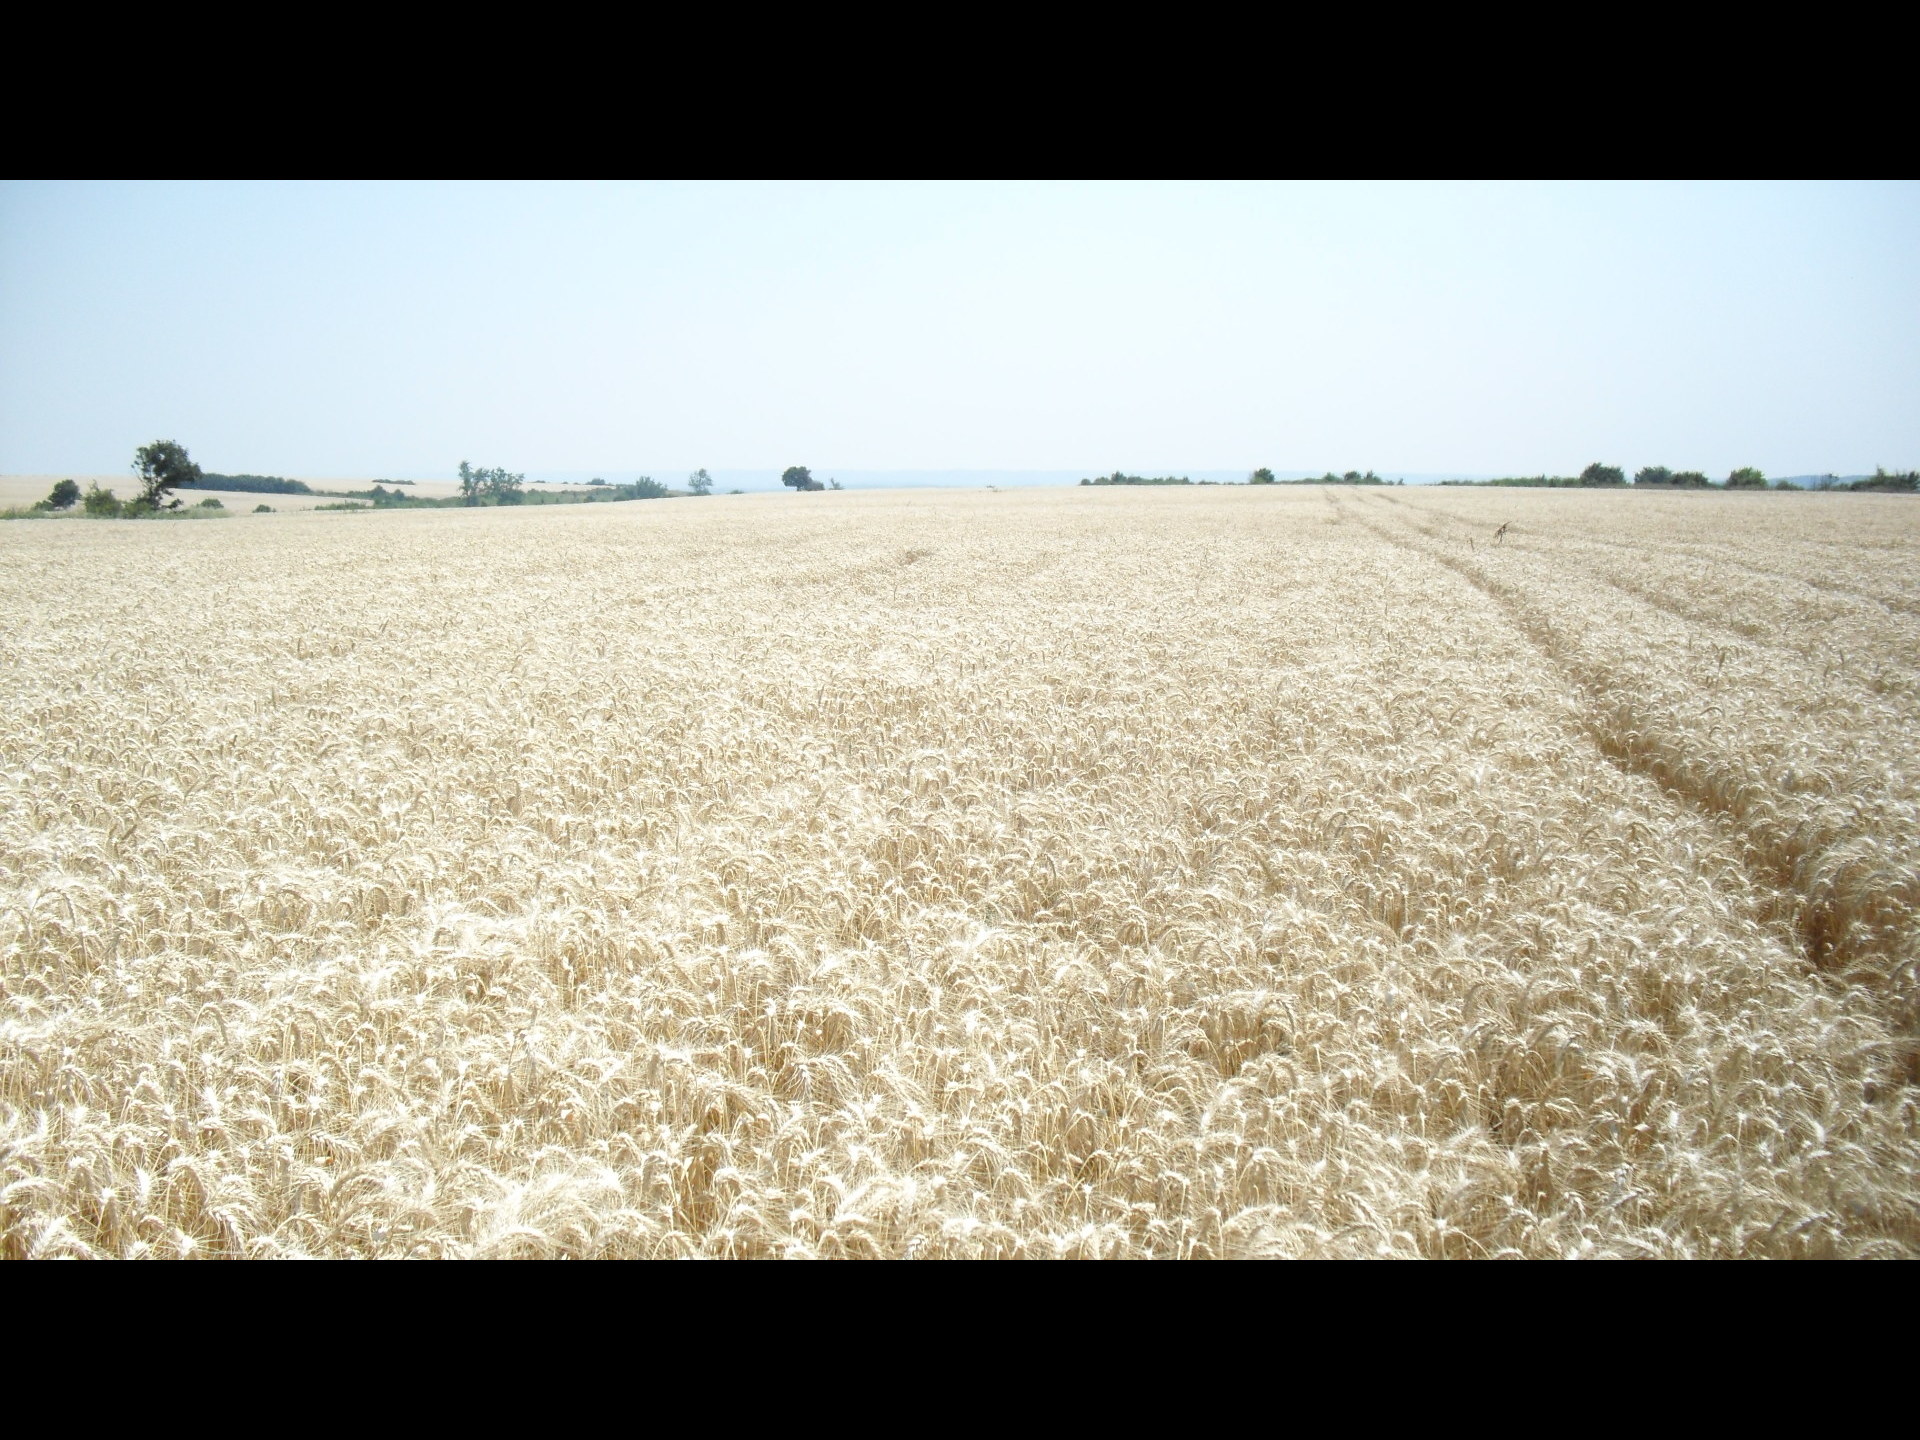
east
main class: Cropland
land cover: Common wheat
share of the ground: > 75 %
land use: Agriculture (excluding fallow land and kitchen gardens)
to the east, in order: Common wheat
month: July
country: BG
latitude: 43.7019
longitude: 22.9308
